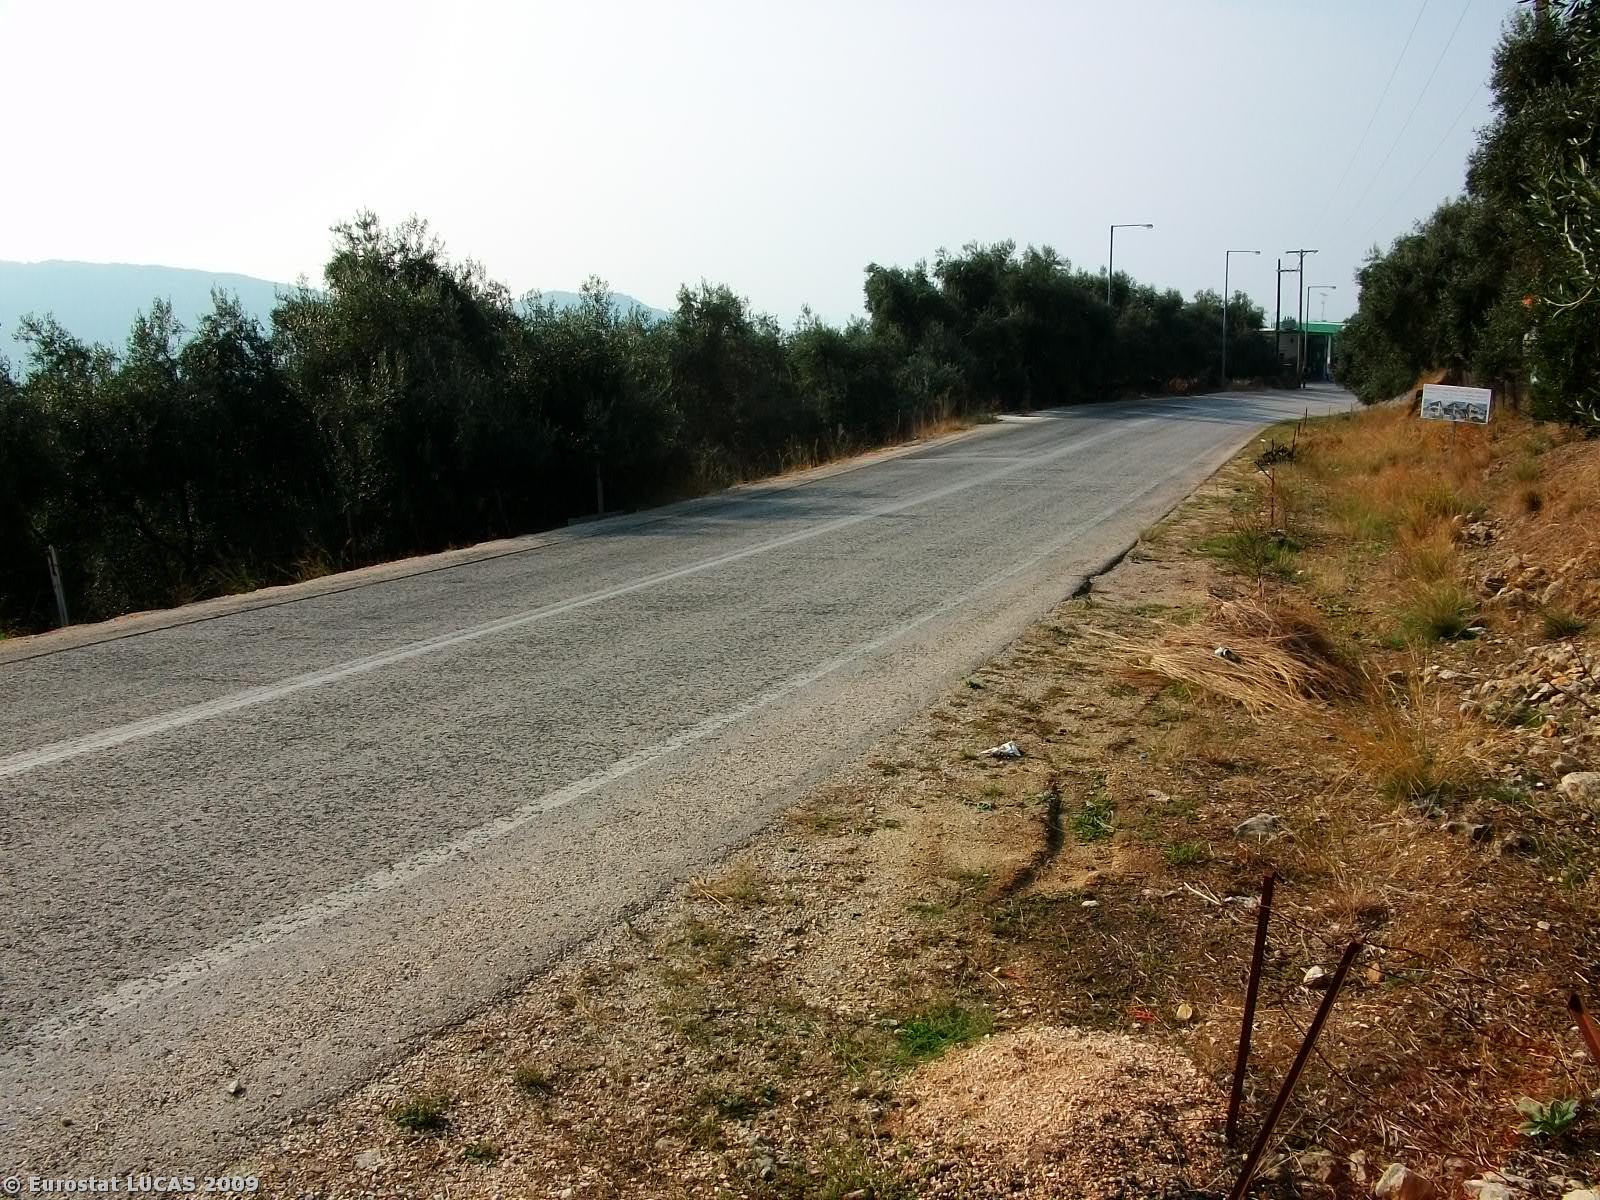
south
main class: Shrubland
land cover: Shrubland without tree cover
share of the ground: > 75 %
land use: Agriculture (excluding fallow land and kitchen gardens)
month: October
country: GR
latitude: 39.2867
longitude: 20.4647
